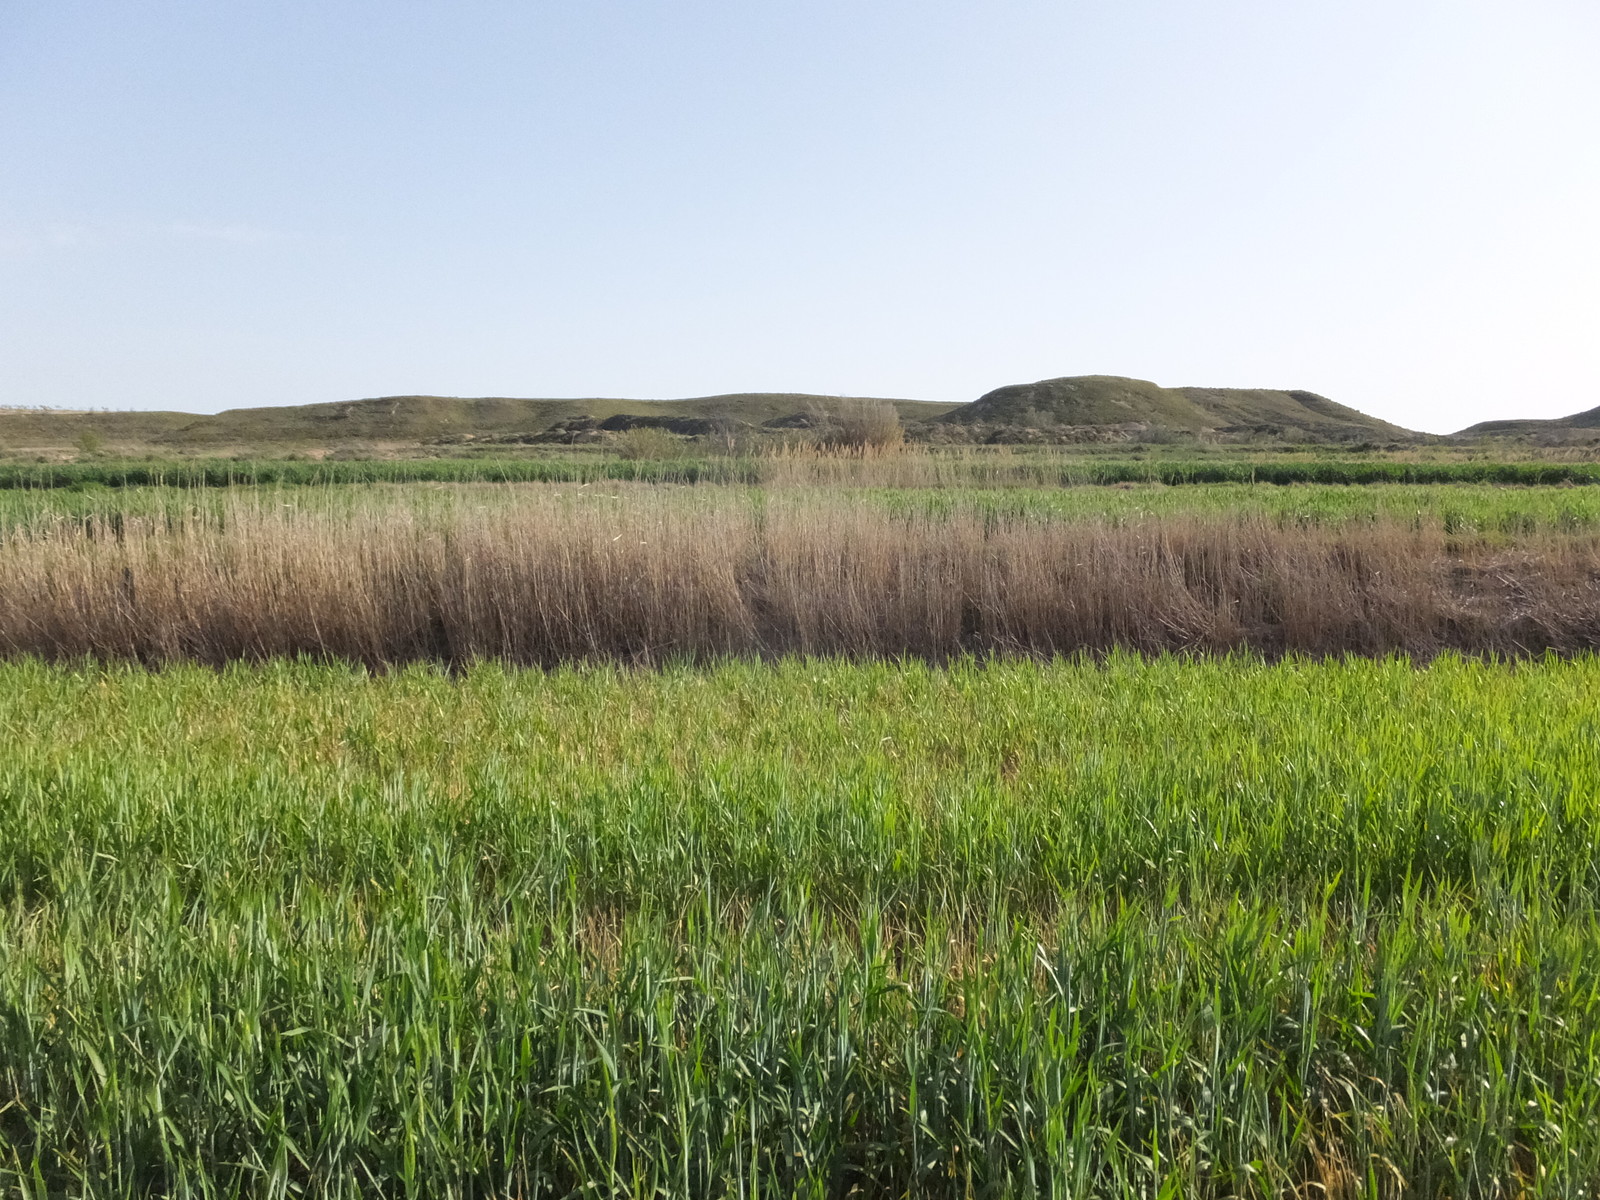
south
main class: Cropland
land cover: Durum wheat
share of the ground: > 75 %
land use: Agriculture (excluding fallow land and kitchen gardens)
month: April
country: ES
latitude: 41.7763
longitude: -0.3535
